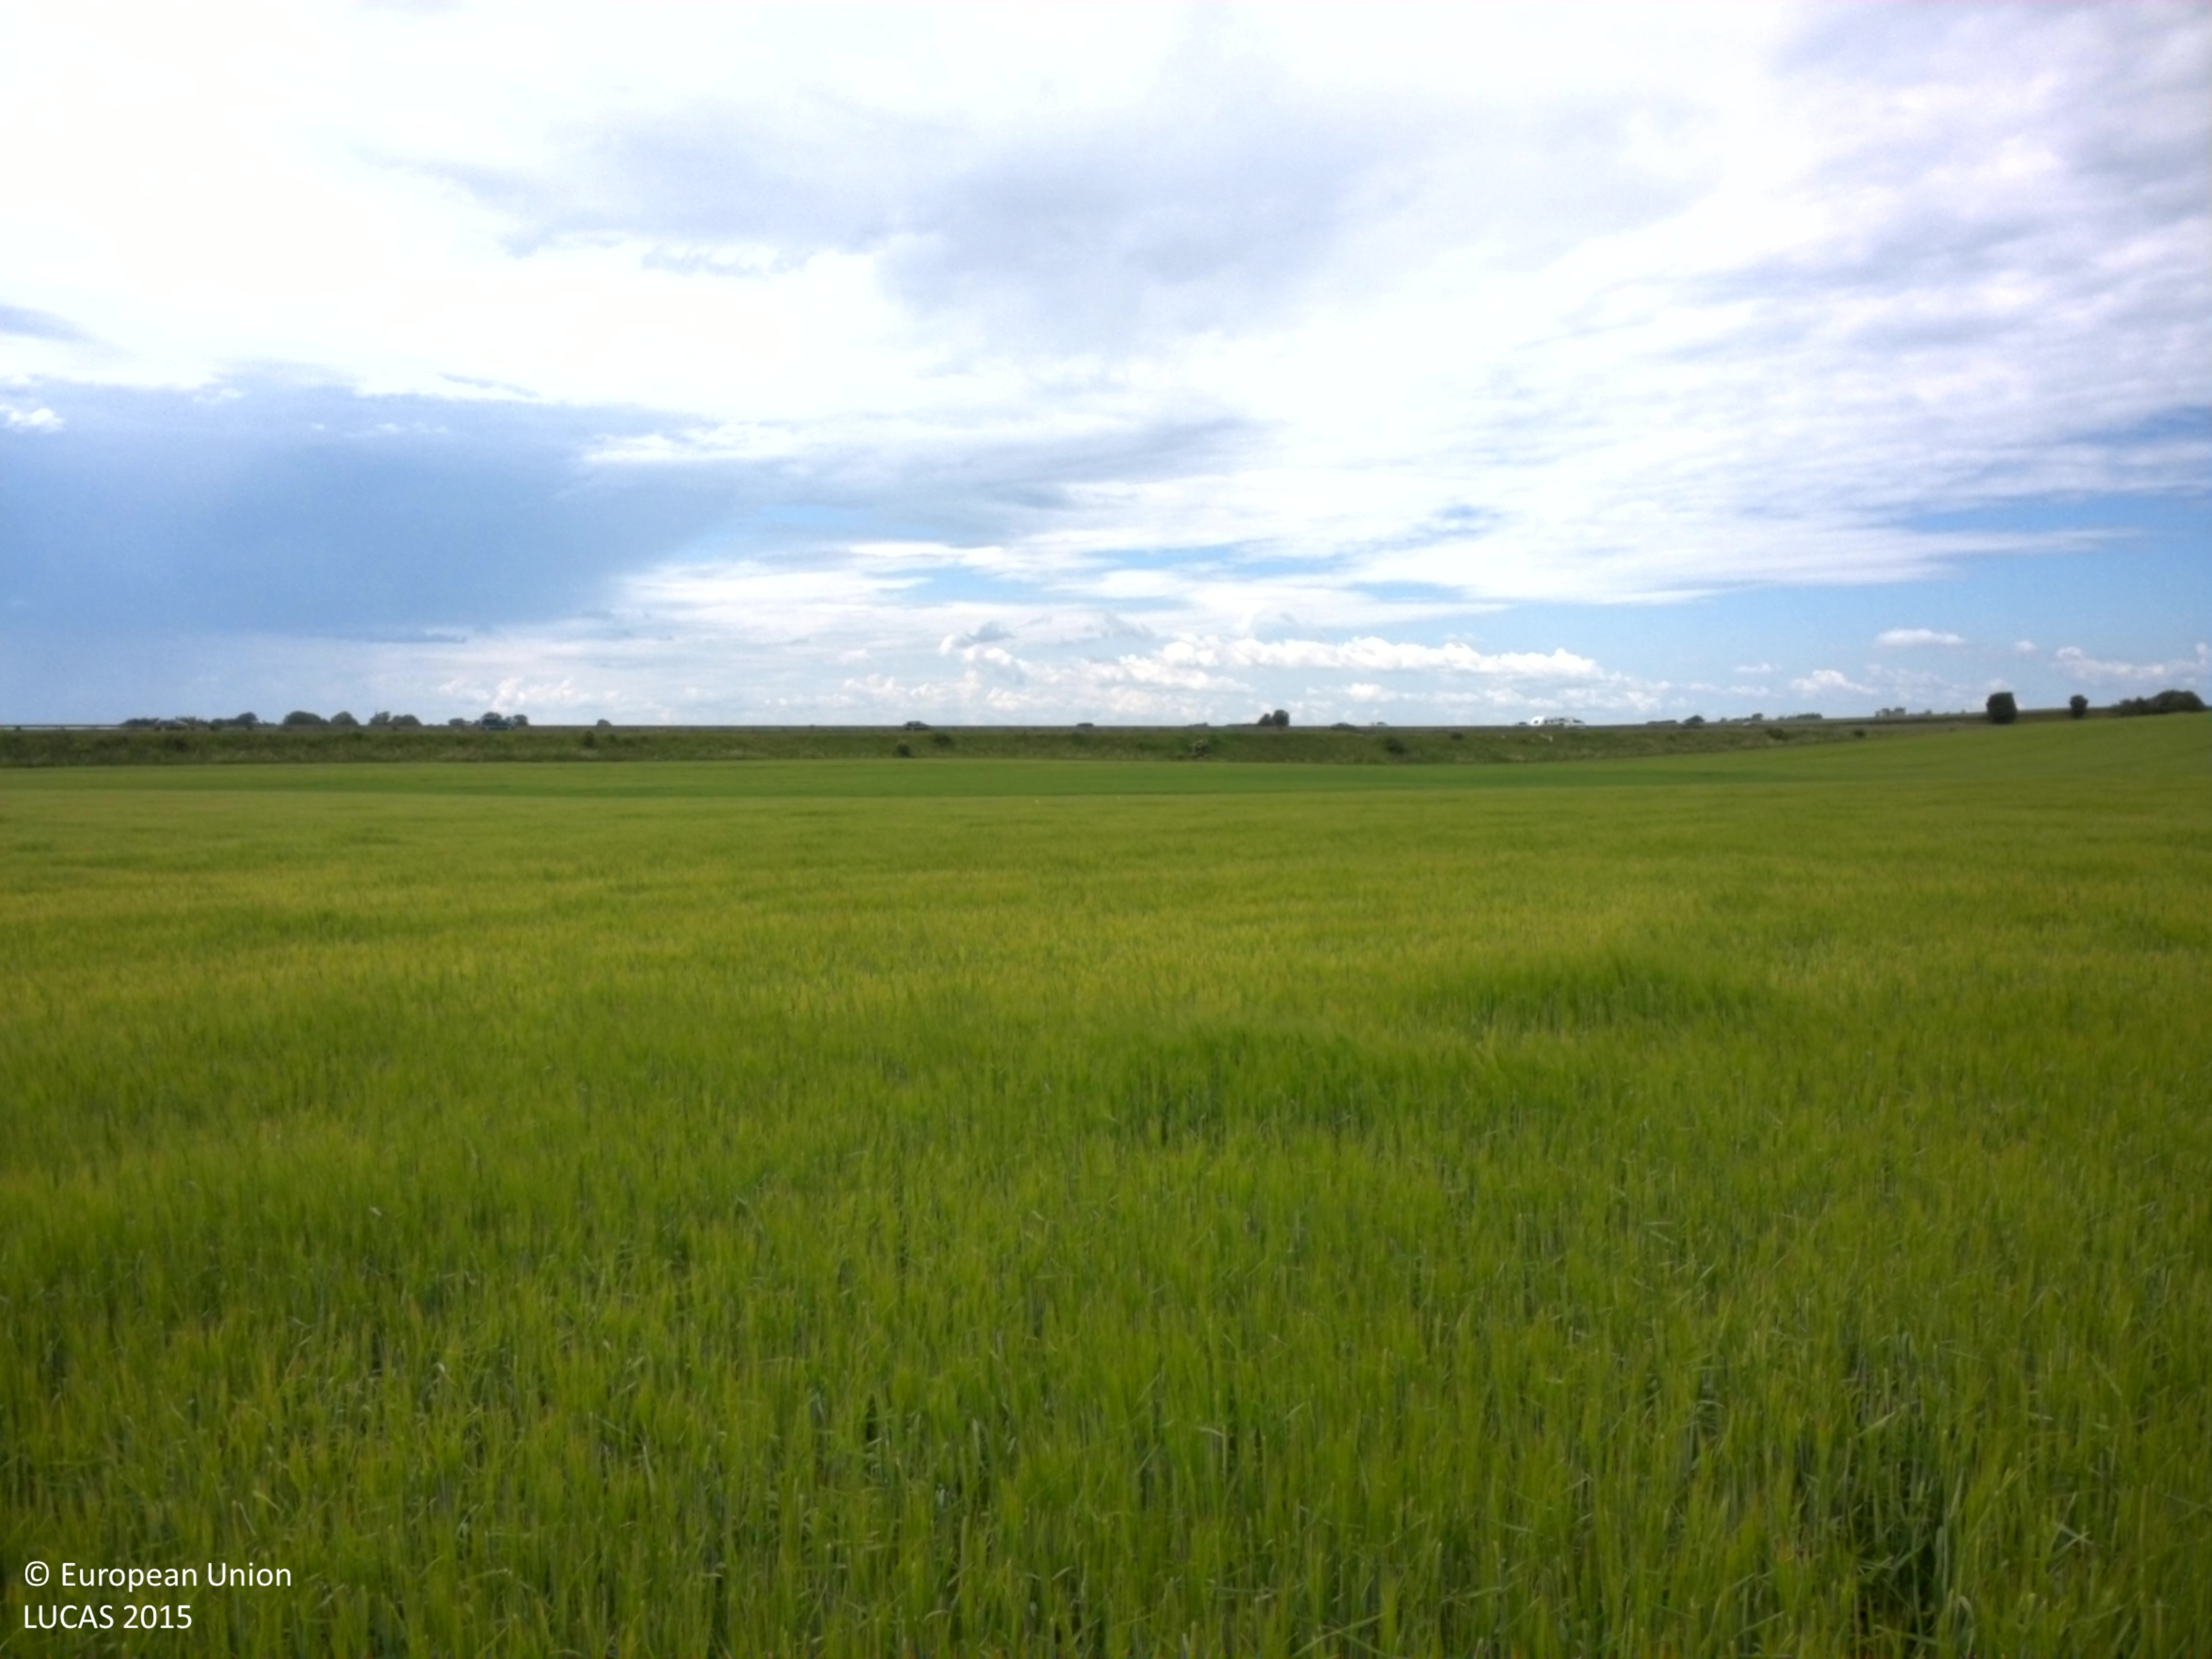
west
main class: Cropland
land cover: Barley
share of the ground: > 75 %
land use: Agriculture (excluding fallow land and kitchen gardens)
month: June
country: SE
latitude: 55.5046
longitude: 13.0221
